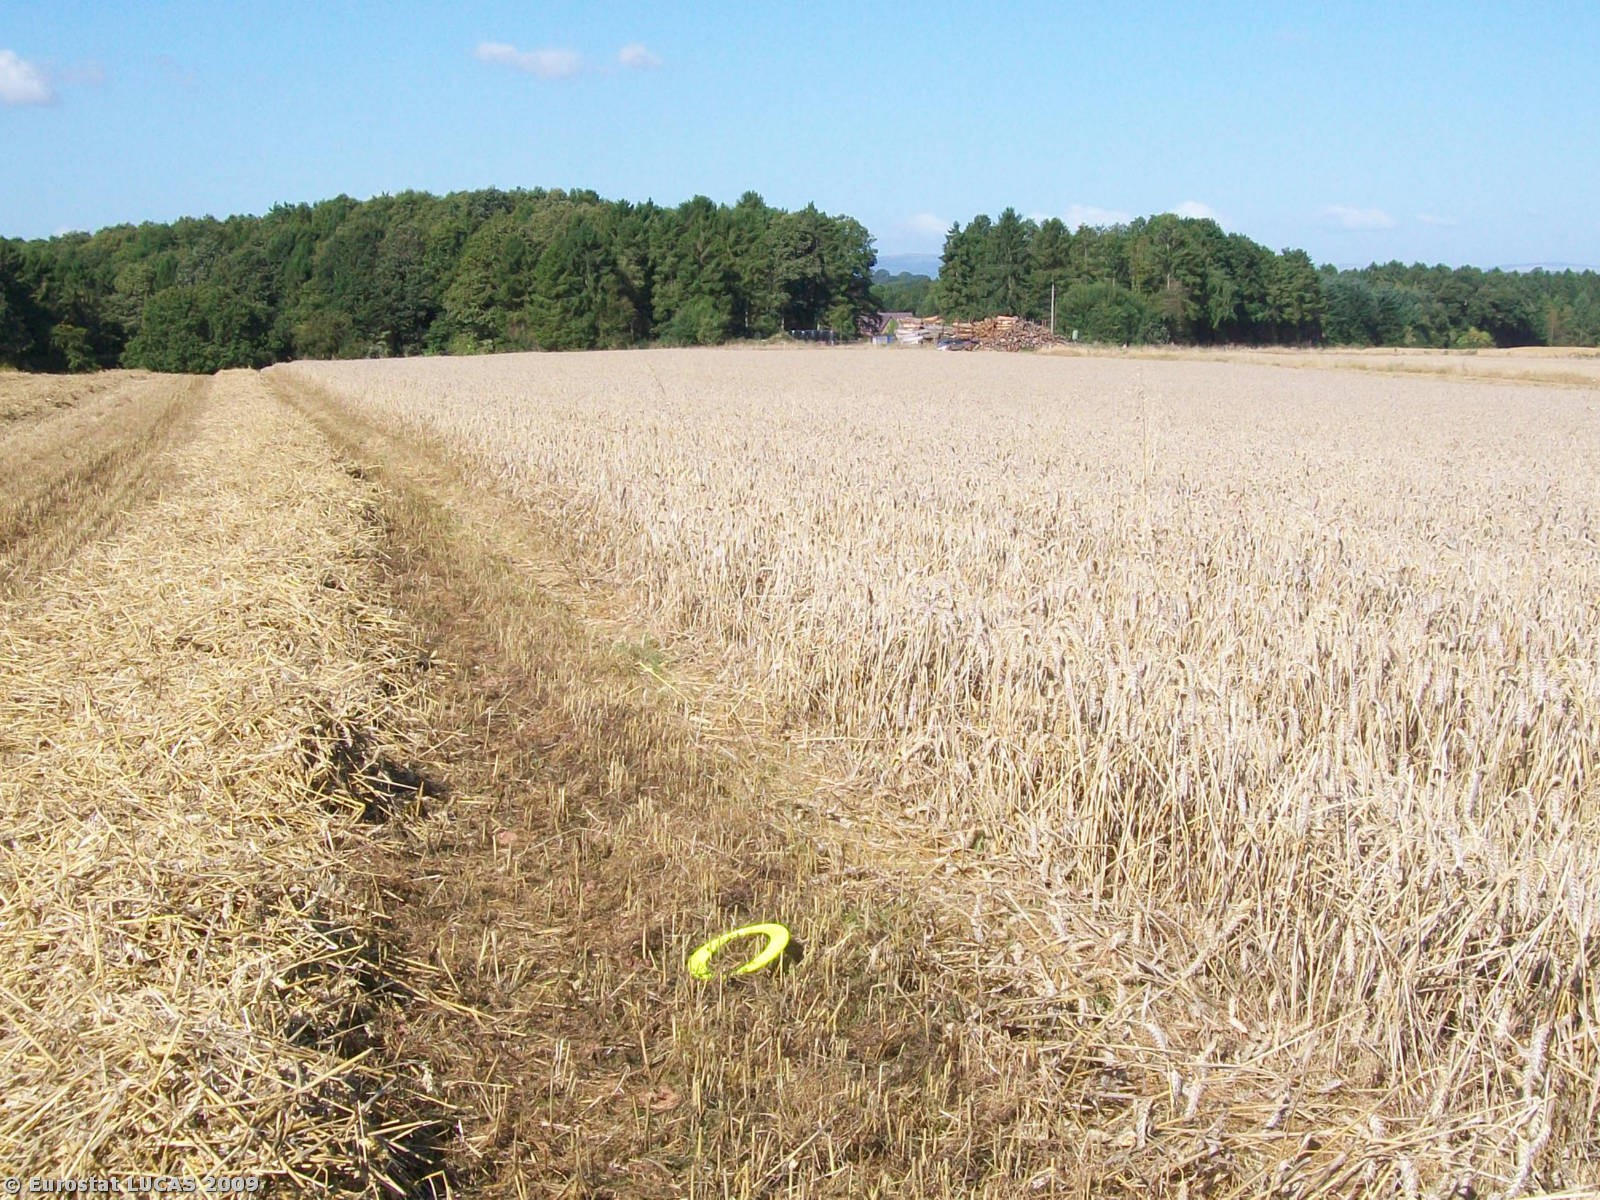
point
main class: Cropland
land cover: Common wheat
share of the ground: > 75 %
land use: Agriculture (excluding fallow land and kitchen gardens)
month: September
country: GB
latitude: 52.2736
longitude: -2.5389
